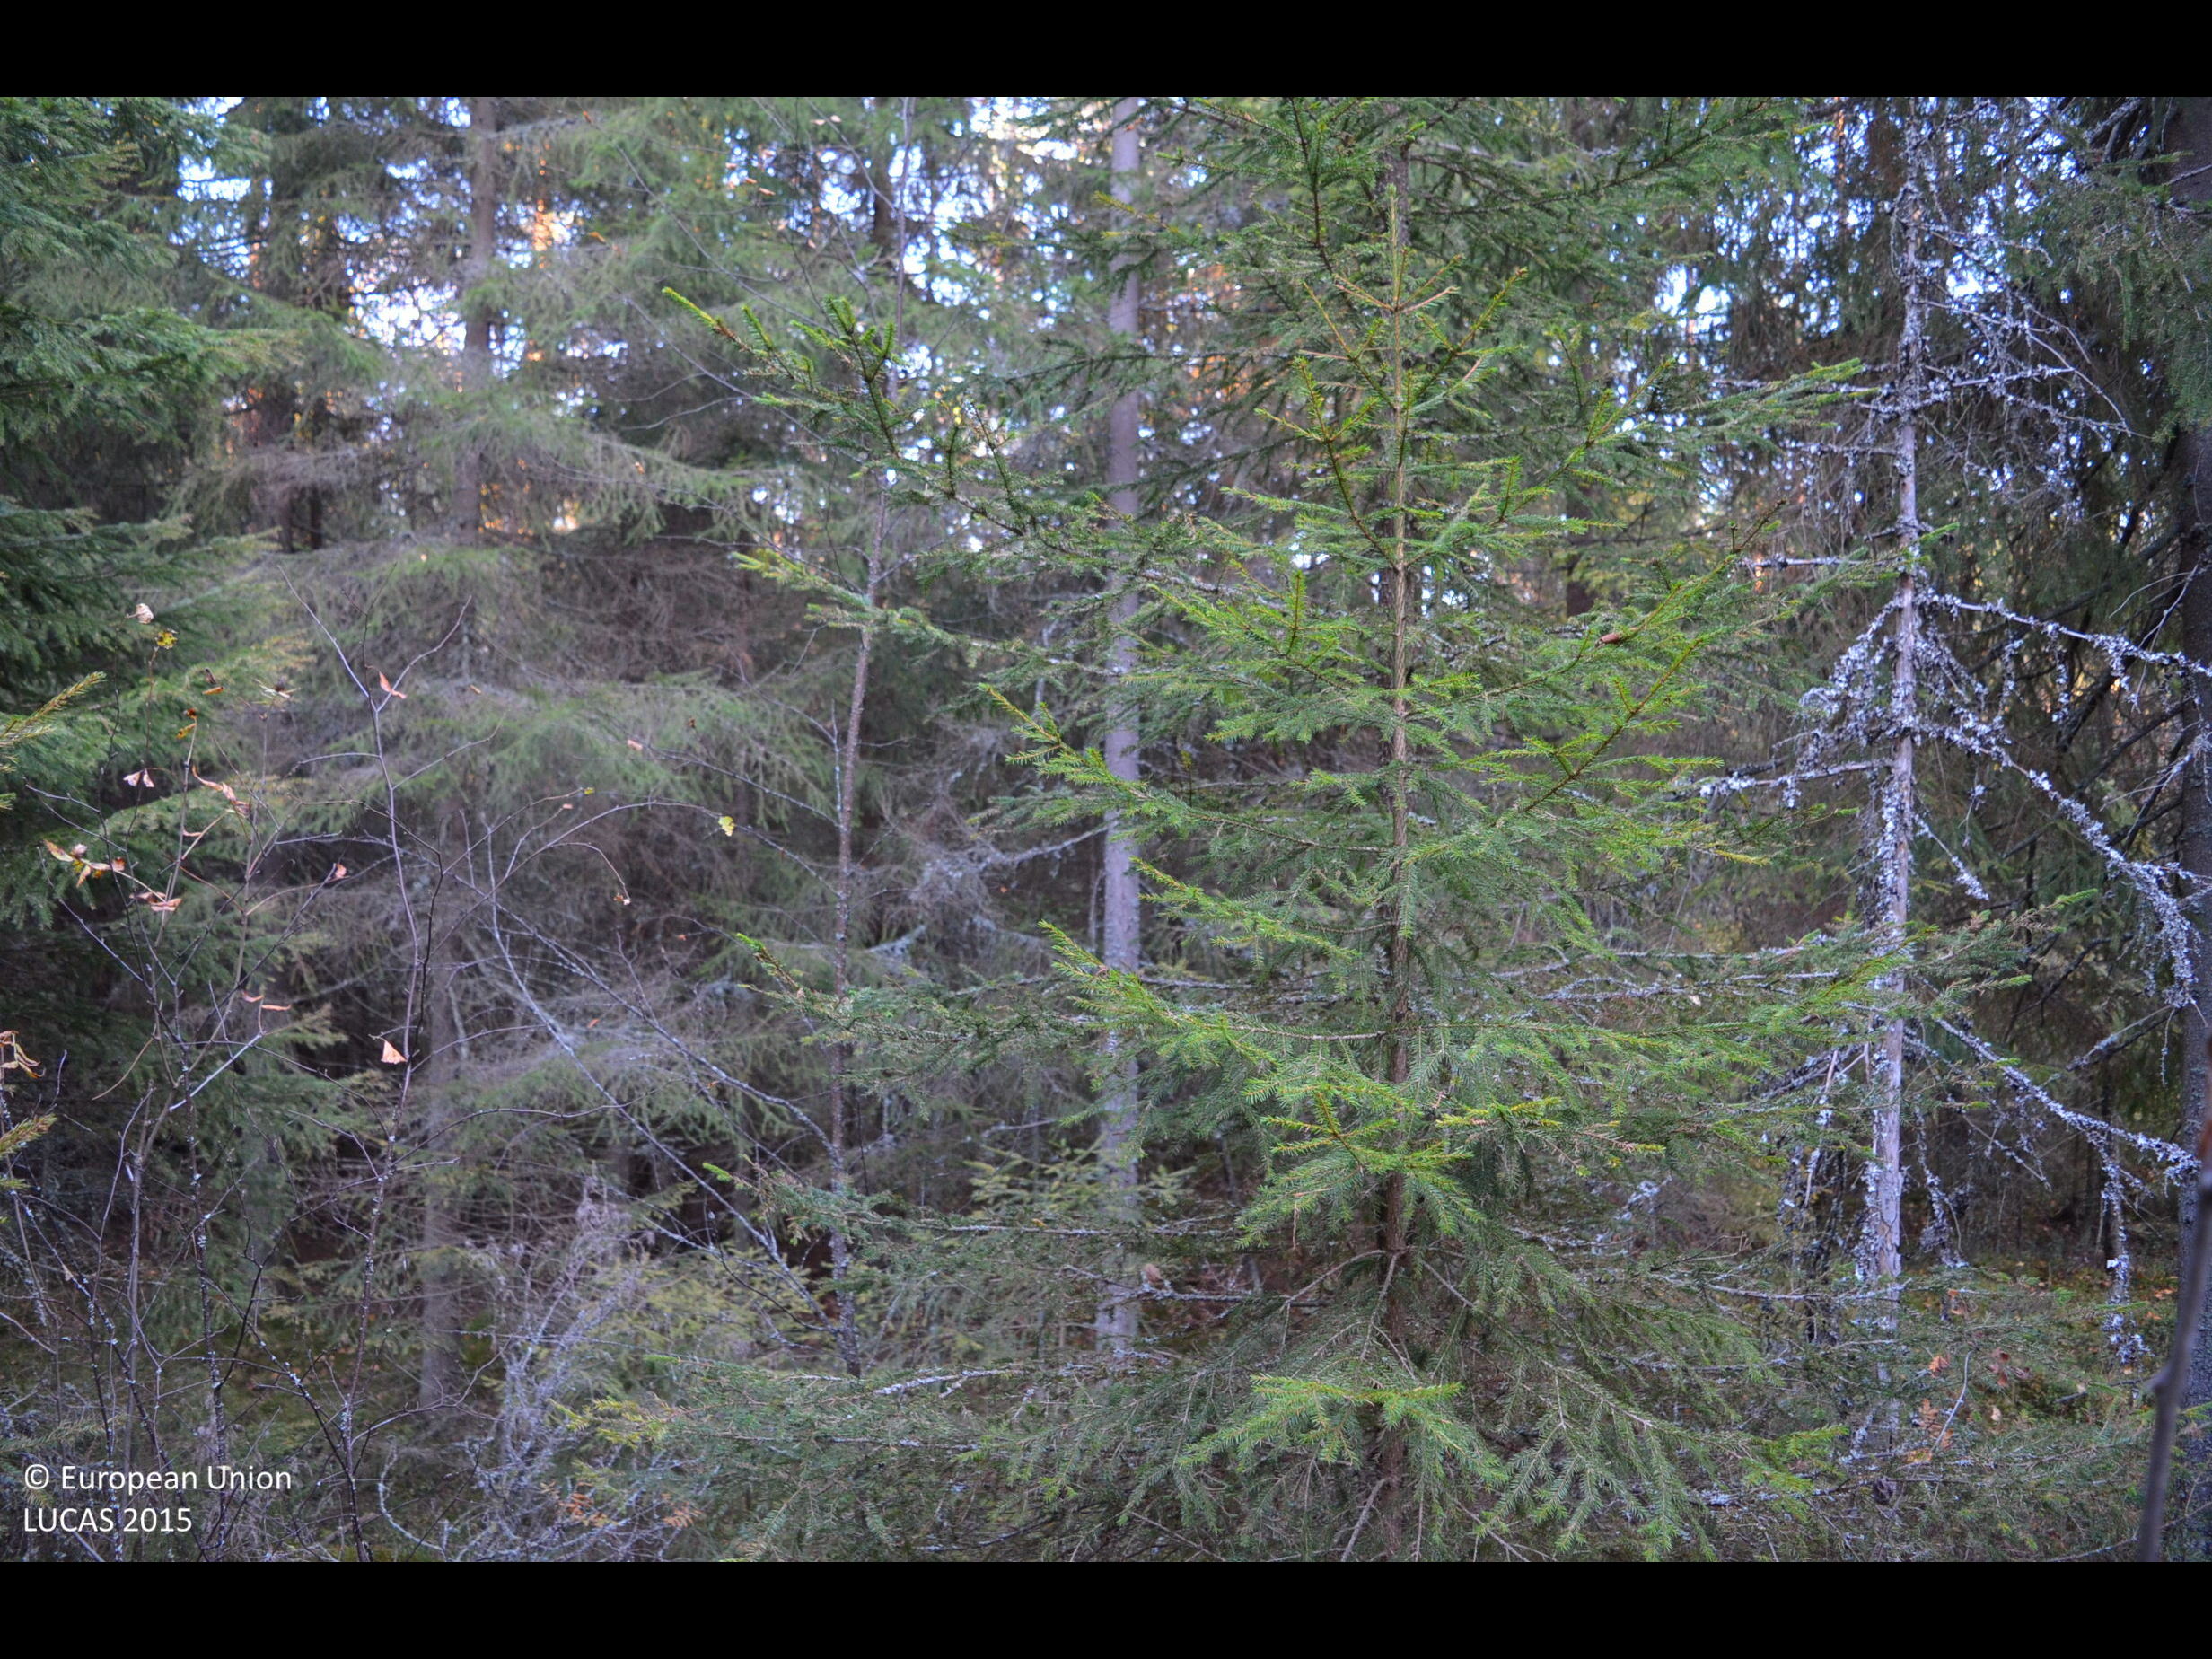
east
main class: Woodland
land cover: Spruce dominated coniferous woodland
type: boreal forest
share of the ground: > 75 %
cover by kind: coniferous forest trees 70 %, shrubs 15 %, broadleaved forest trees 10 %, lichens and mosses 5 %
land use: Forestry
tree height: > 5 m
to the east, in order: Spruce dominated coniferous woodland; Ditches and canals; Other mixed woodland; Ditches and canals; Spruce dominated mixed woodland; Ditches and canals; Spruce dominated mixed woodland; Ditches and canals; Spruce dominated mixed woodland; Ditches and canals; Spruce dominated coniferous woodland; Ditches and canals; Spruce dominated coniferous woodland; Ditches and canals; Other coniferous woodland; Spruce dominated coniferous woodland
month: October
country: FI
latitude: 61.7829
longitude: 23.8670
